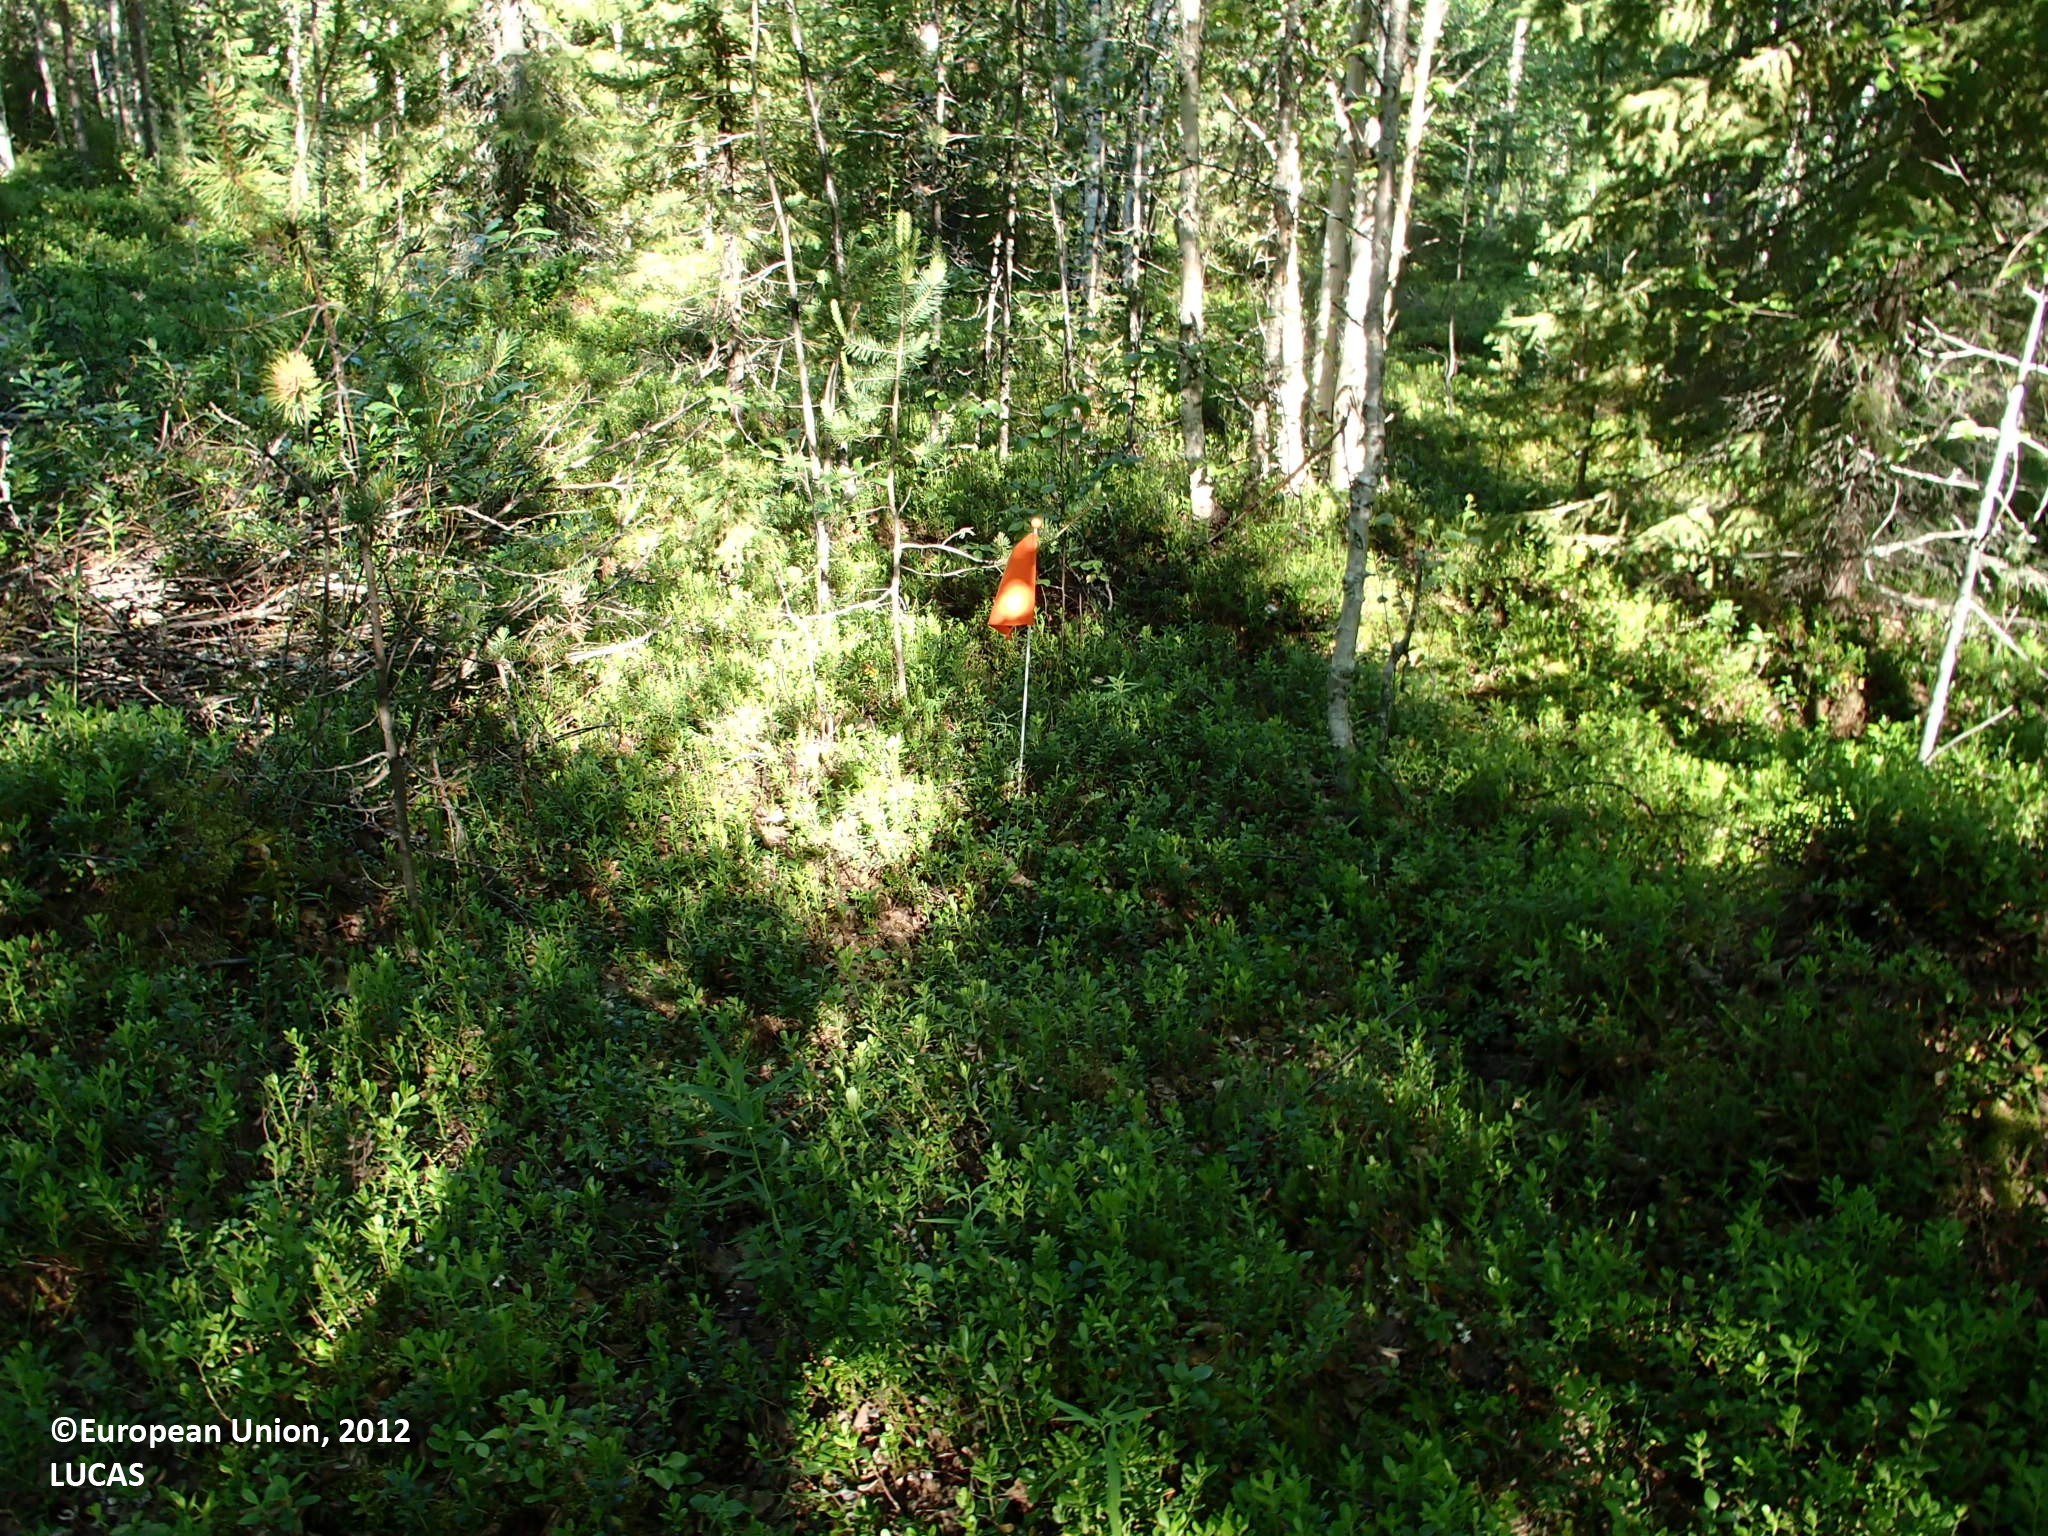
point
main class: Woodland
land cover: Other mixed woodland
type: boreal forest
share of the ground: > 75 %
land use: Forestry
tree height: > 5 m
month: July
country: FI
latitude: 66.8564
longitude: 25.4478
